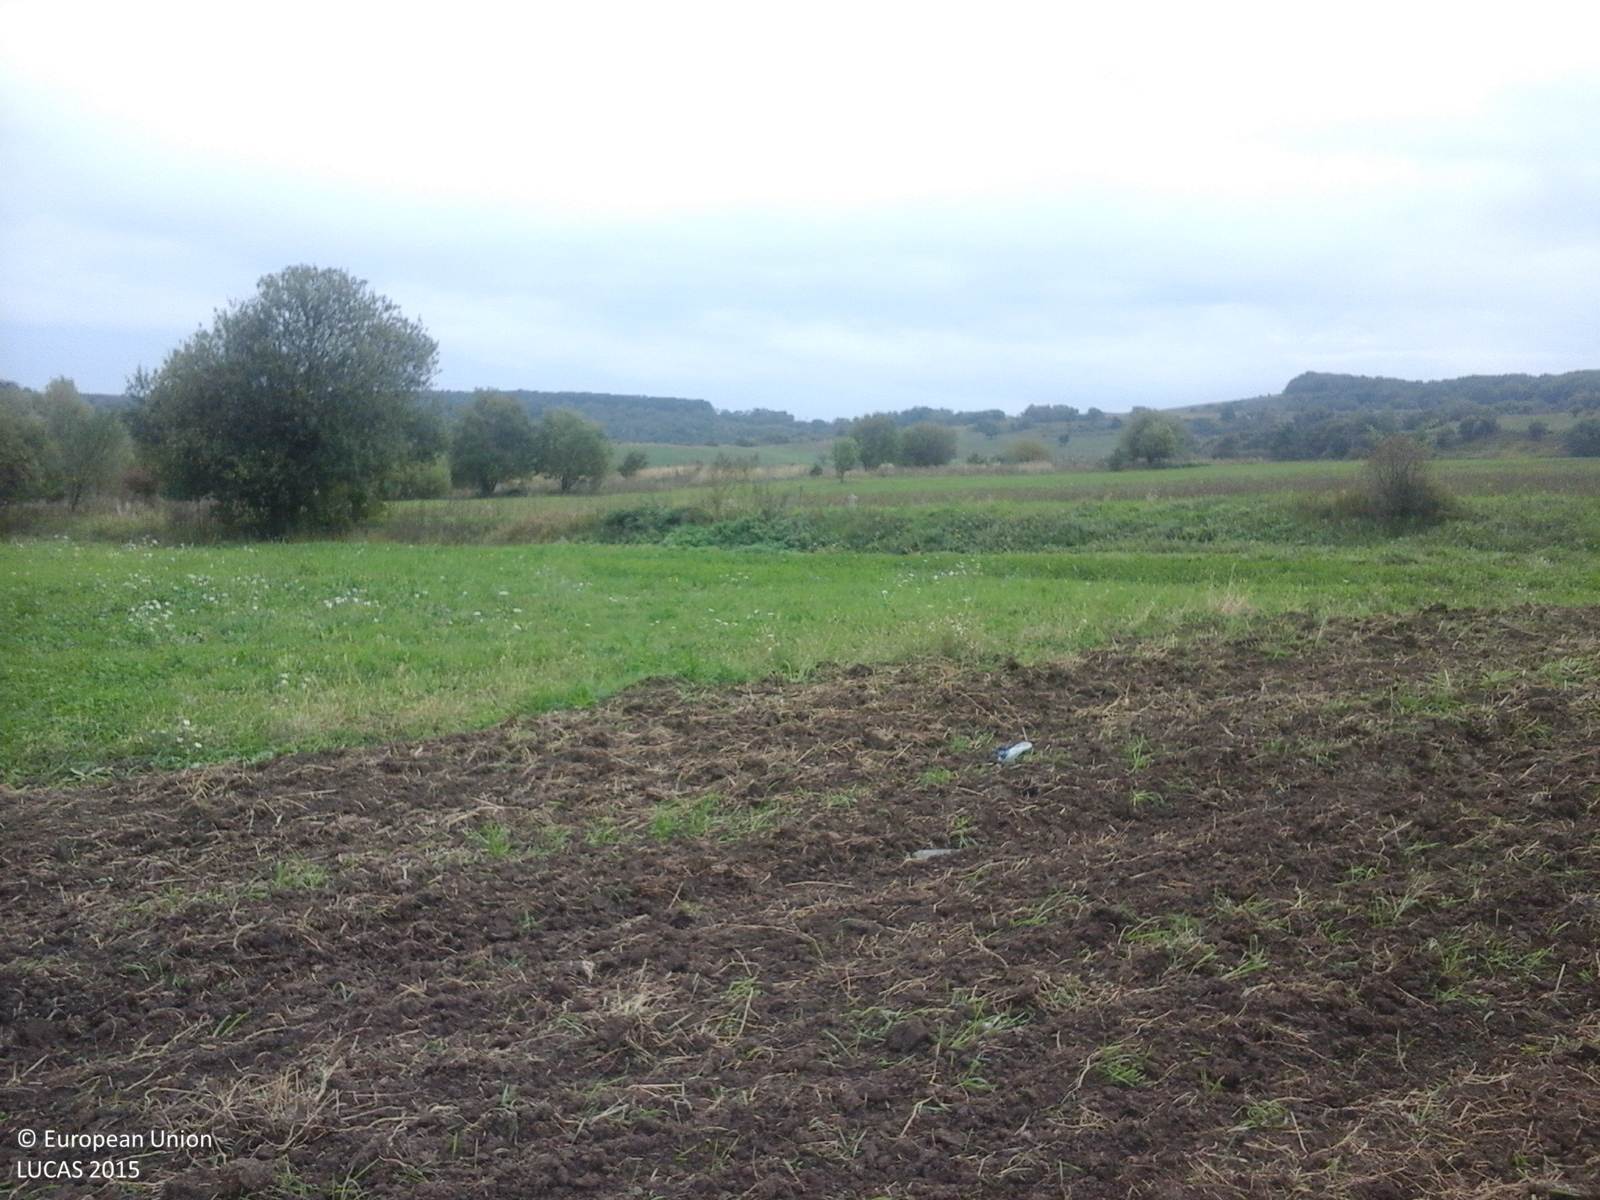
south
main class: Cropland
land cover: Common wheat
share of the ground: < 10 %
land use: Agriculture (excluding fallow land and kitchen gardens)
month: October
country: RO
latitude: 46.5453
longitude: 24.8971
